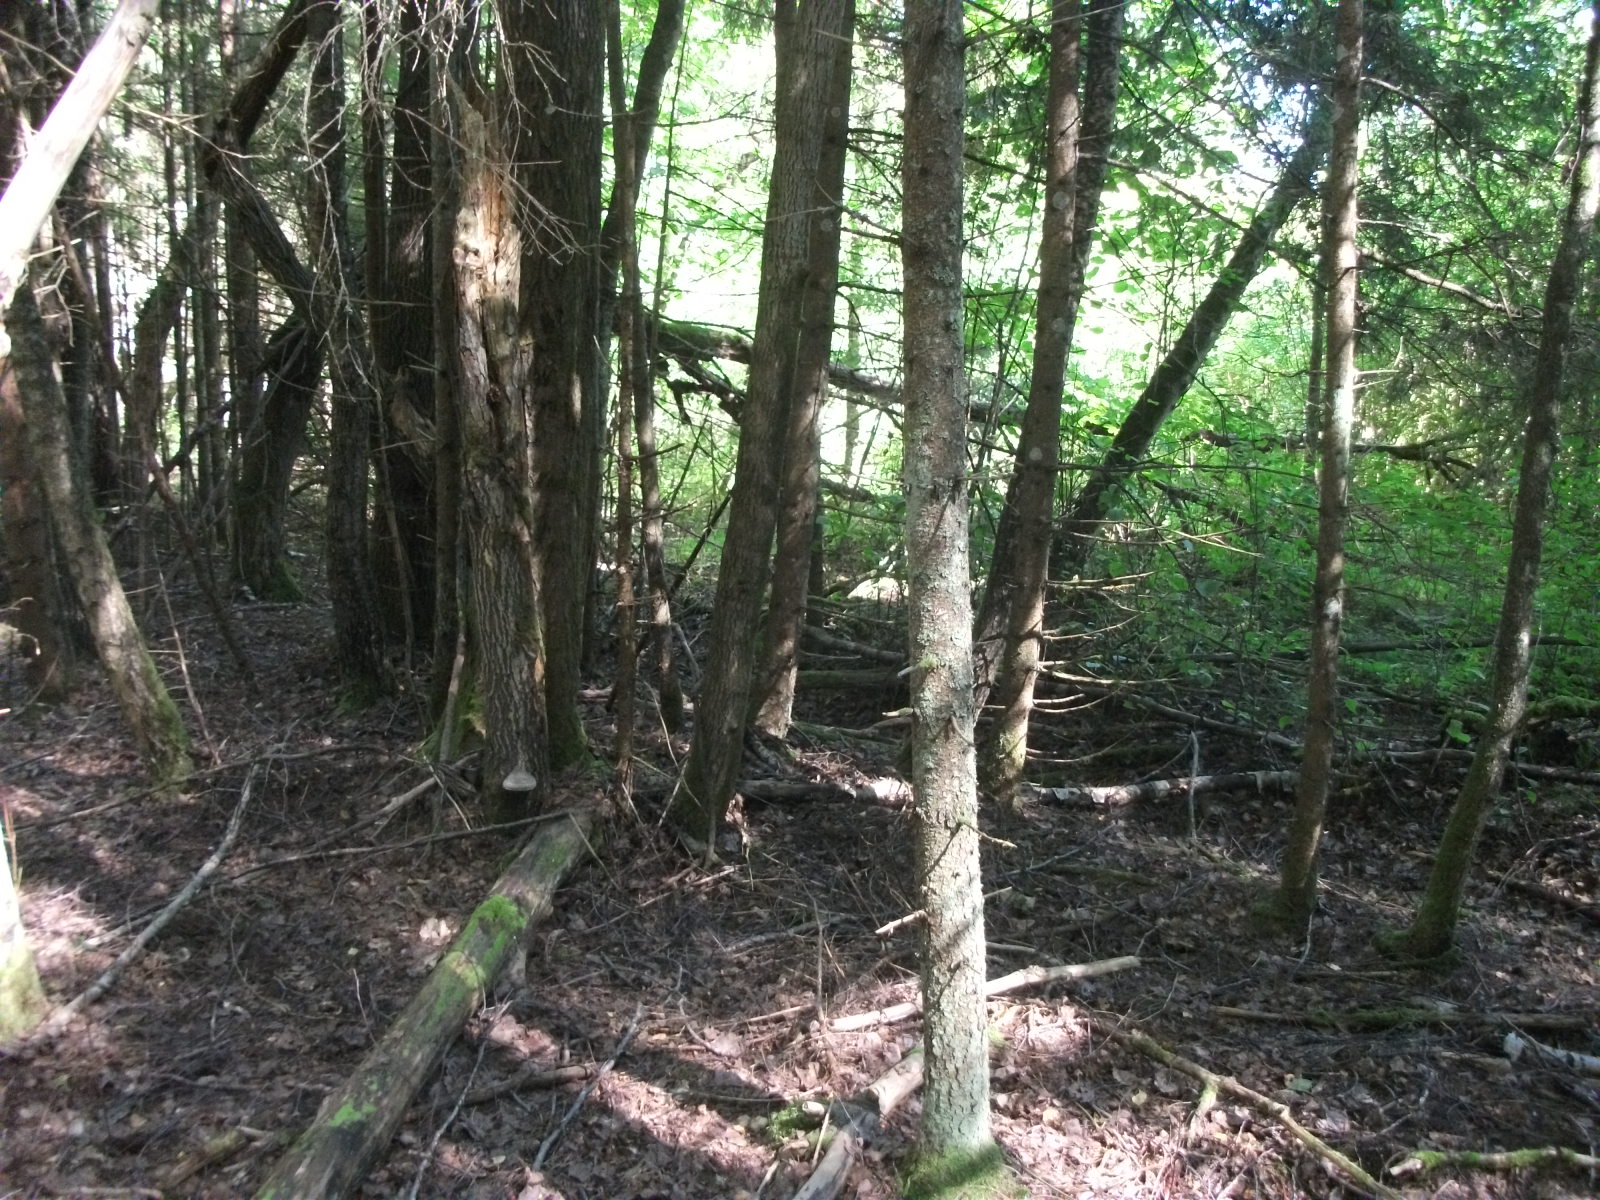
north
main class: Woodland
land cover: Spruce dominated mixed woodland
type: hemiboreal forest and nemoral coniferous forest and mixed broadleaved-coniferous forest
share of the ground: > 75 %
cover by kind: coniferous forest trees 50 %, broadleaved forest trees 35 %, lichens and mosses 10 %, herbaceous plants 5 %
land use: Forestry
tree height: > 5 m
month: August
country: LV
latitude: 57.0481
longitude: 26.4461
